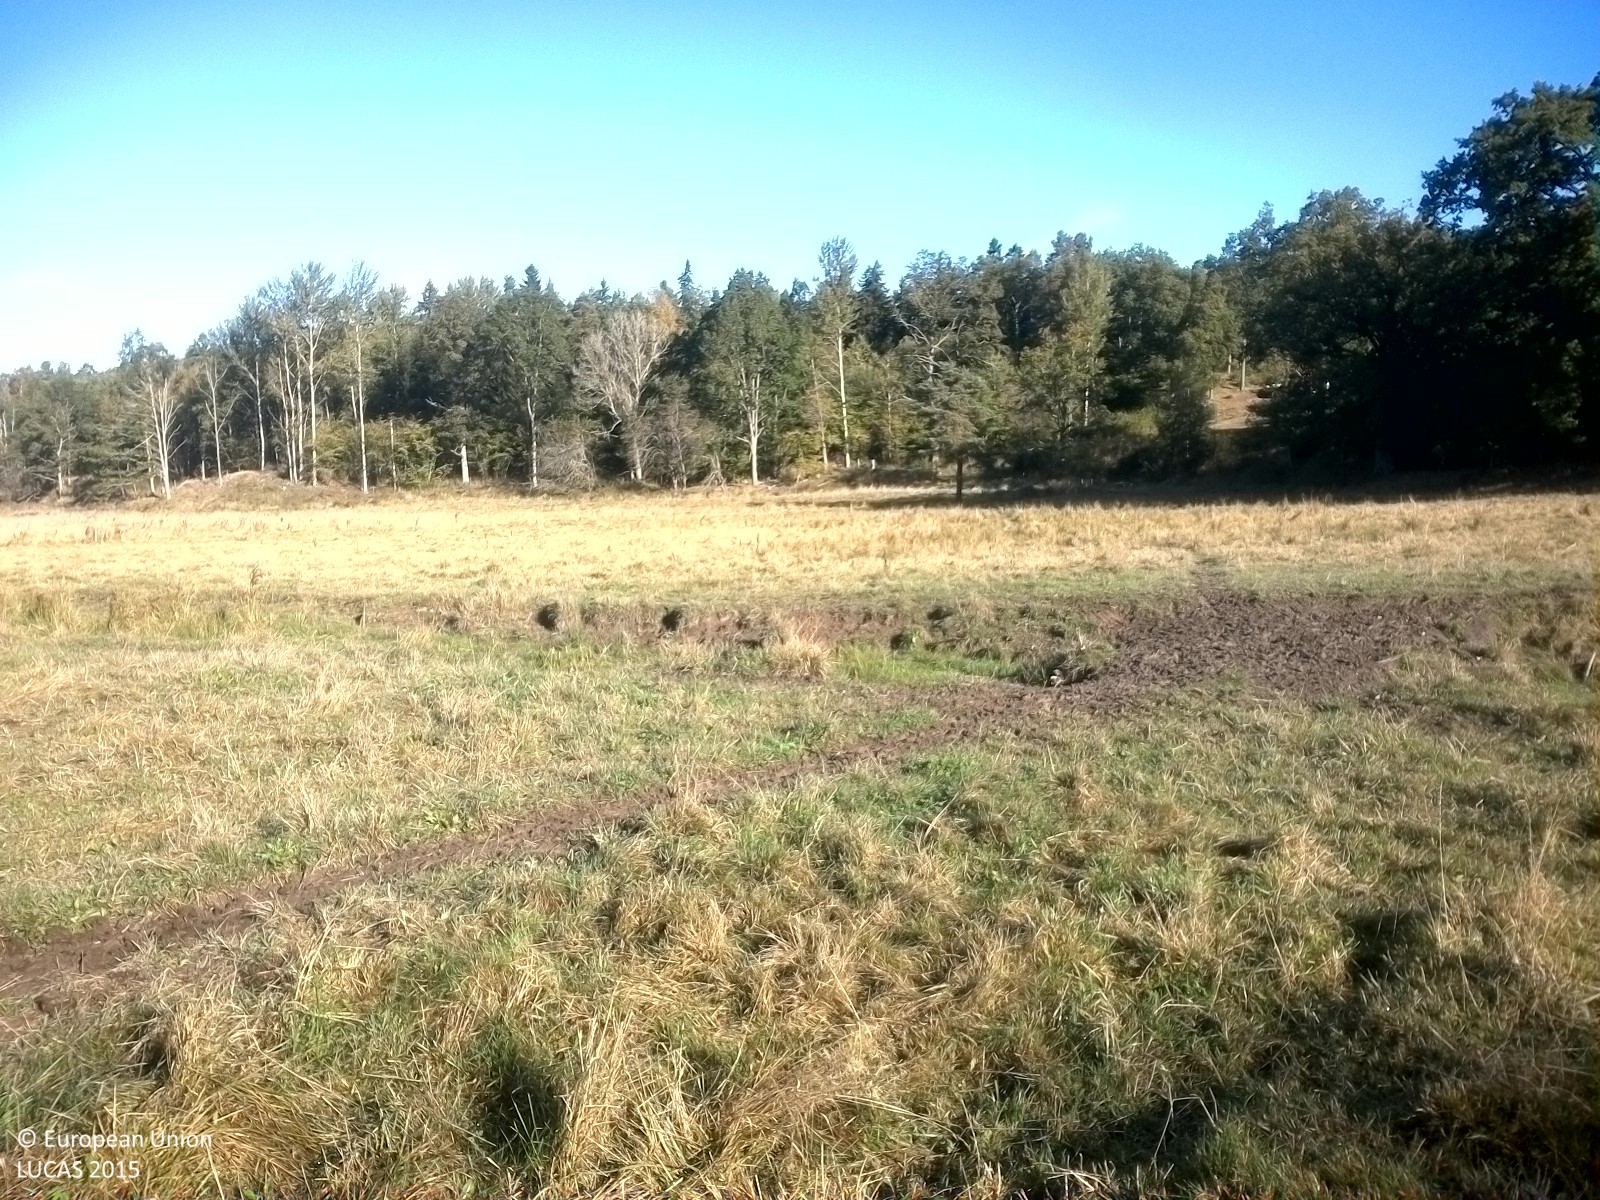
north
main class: Grassland
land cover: Grassland without tree/shrub cover
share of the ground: > 75 %
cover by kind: herbaceous plants 100 %
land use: Agriculture (excluding fallow land and kitchen gardens)
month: September
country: SE
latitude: 58.4465
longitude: 16.7646
